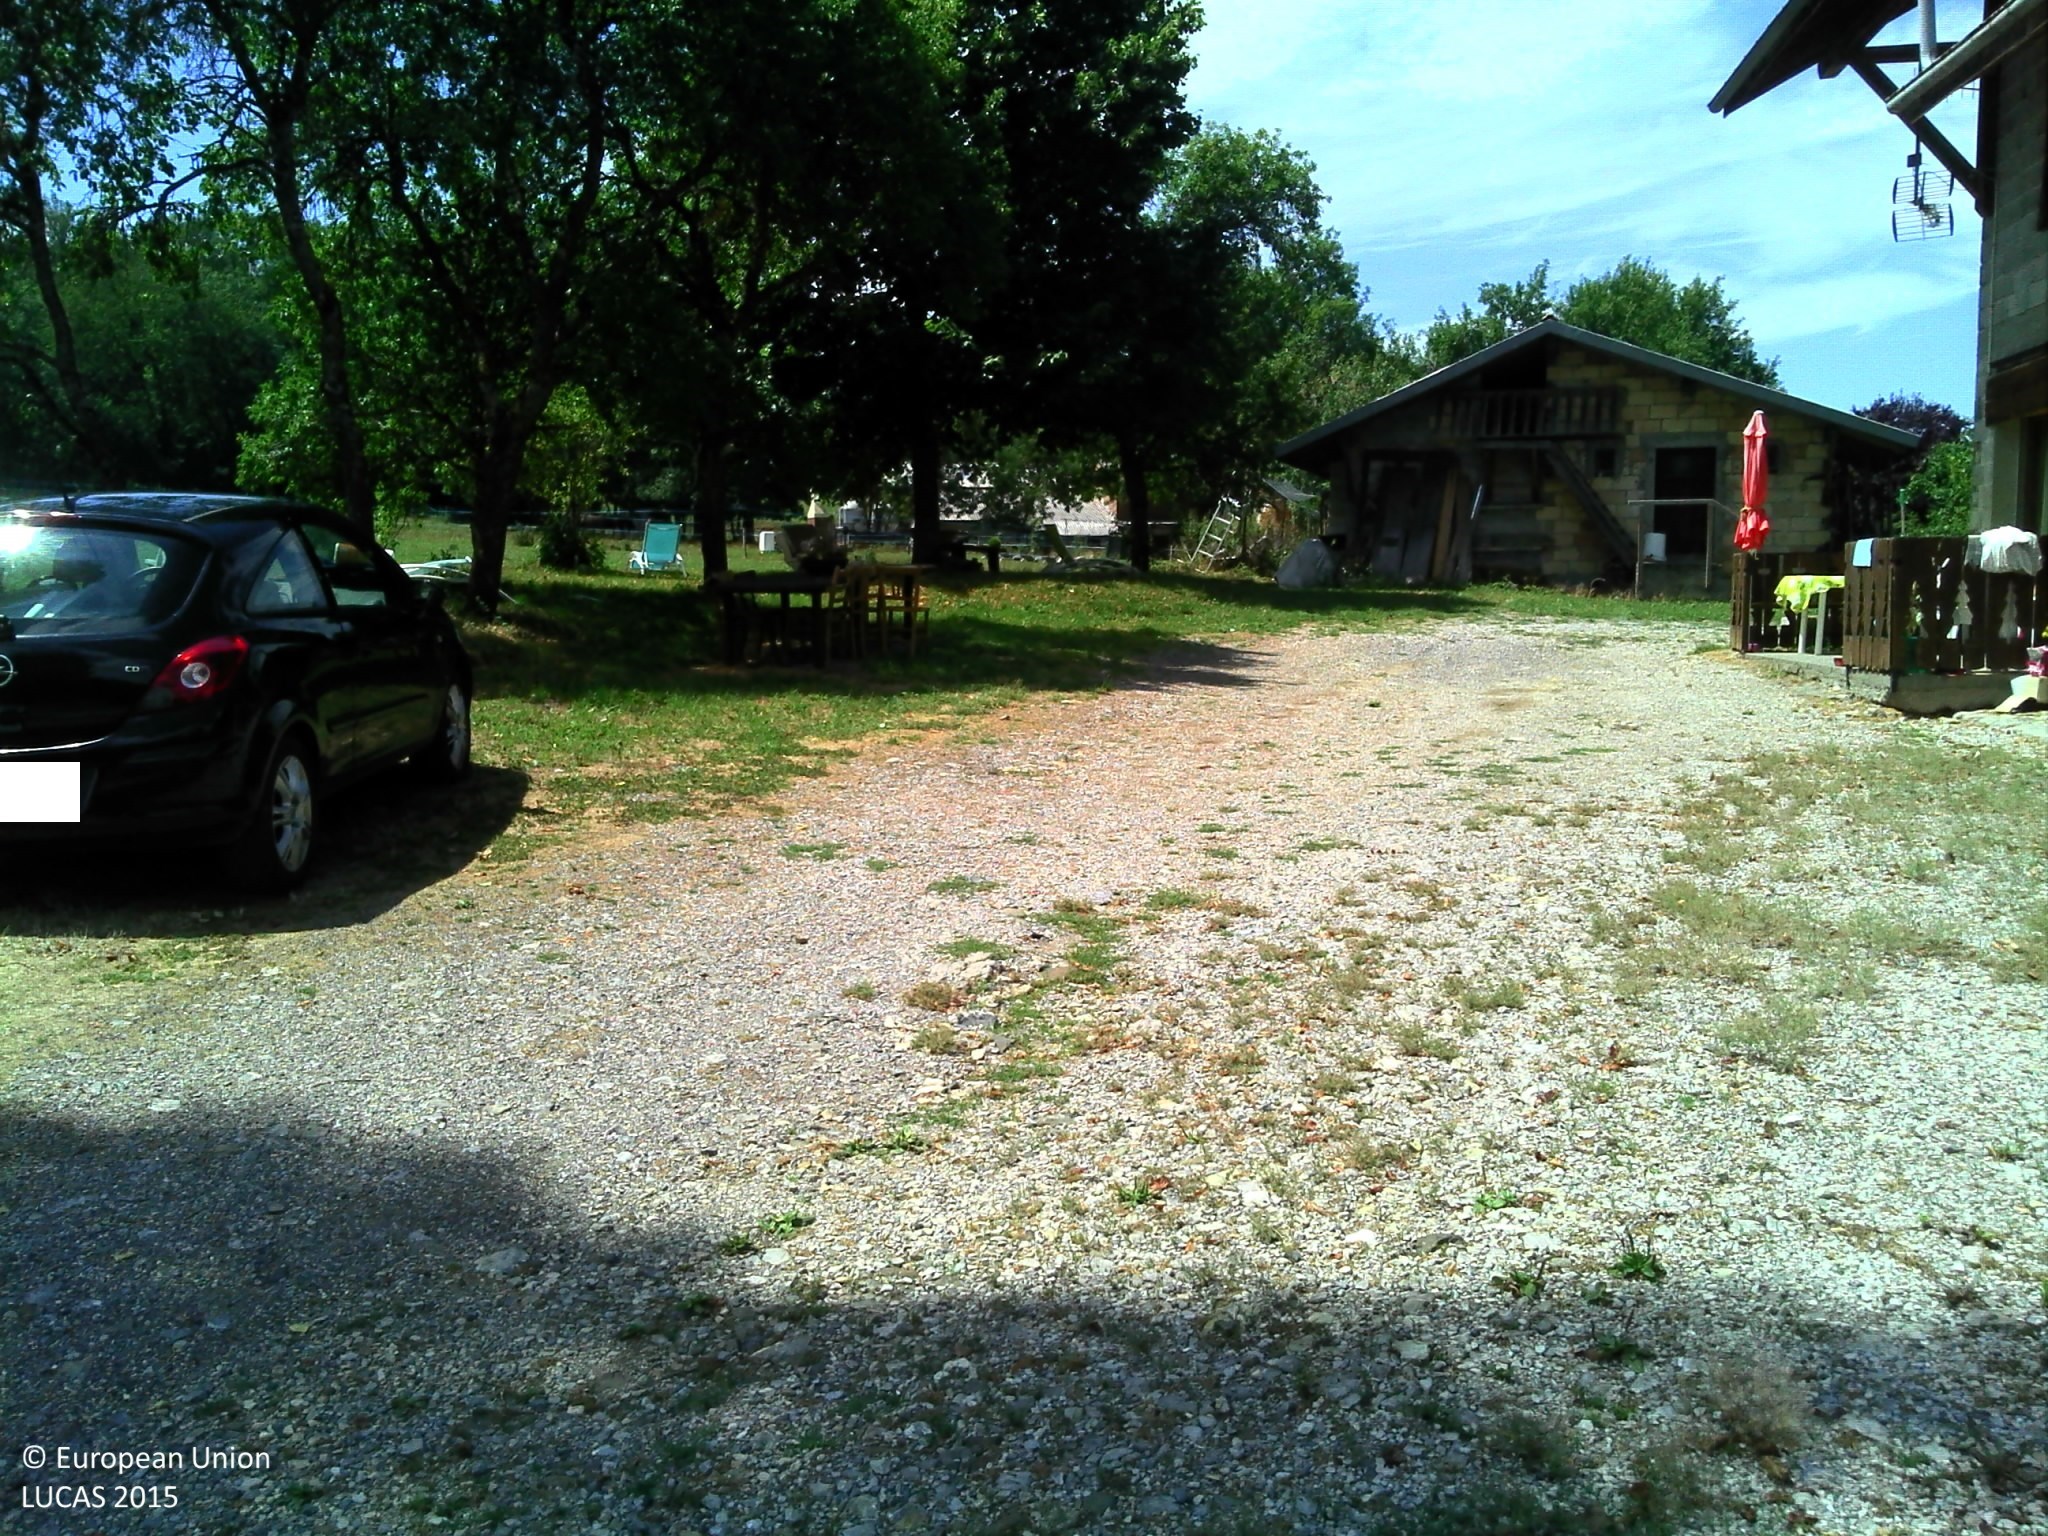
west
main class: Grassland
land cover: Grassland without tree/shrub cover
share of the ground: > 75 %
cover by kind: herbaceous plants 100 %
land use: Residential
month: July
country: FR
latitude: 46.1101
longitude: 6.3939
